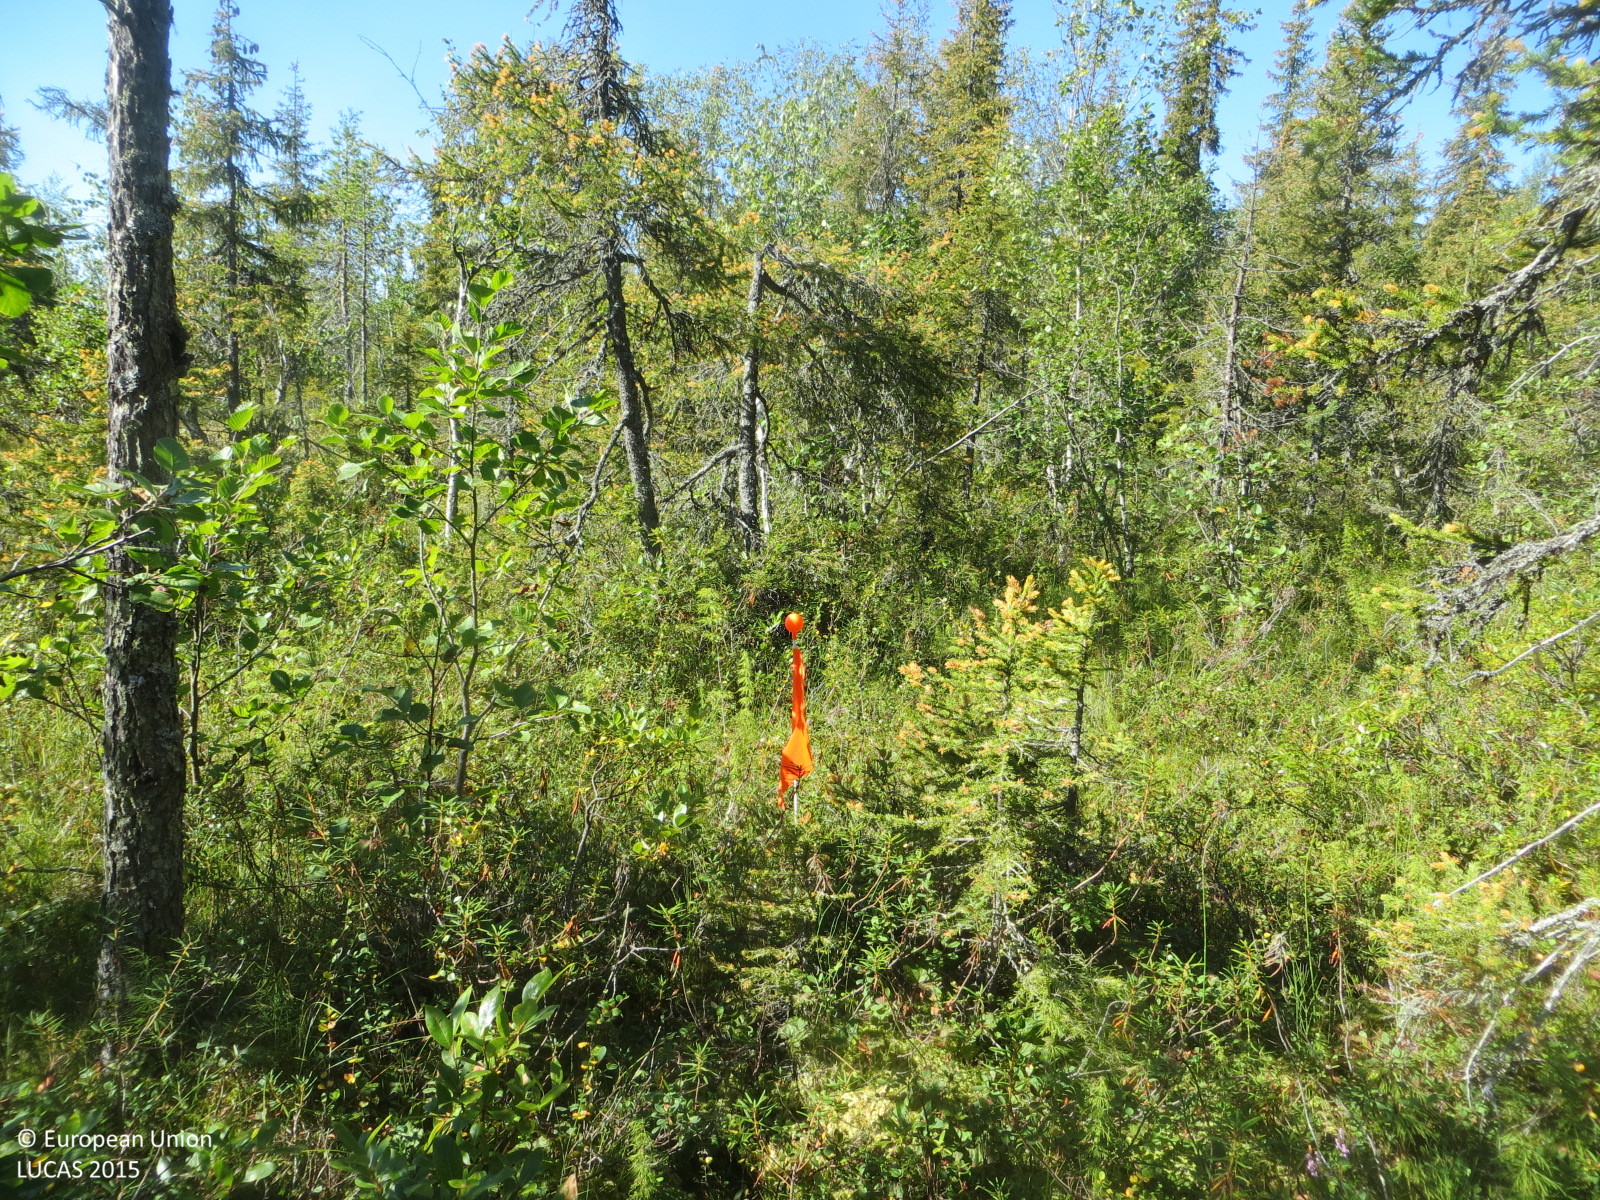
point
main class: Woodland
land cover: Spruce dominated mixed woodland
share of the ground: 50 - 75 %
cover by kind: shrubs 50 %, coniferous forest trees 25 %, broadleaved forest trees 25 %
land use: Forestry
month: August
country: FI
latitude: 67.1733
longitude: 23.9087
